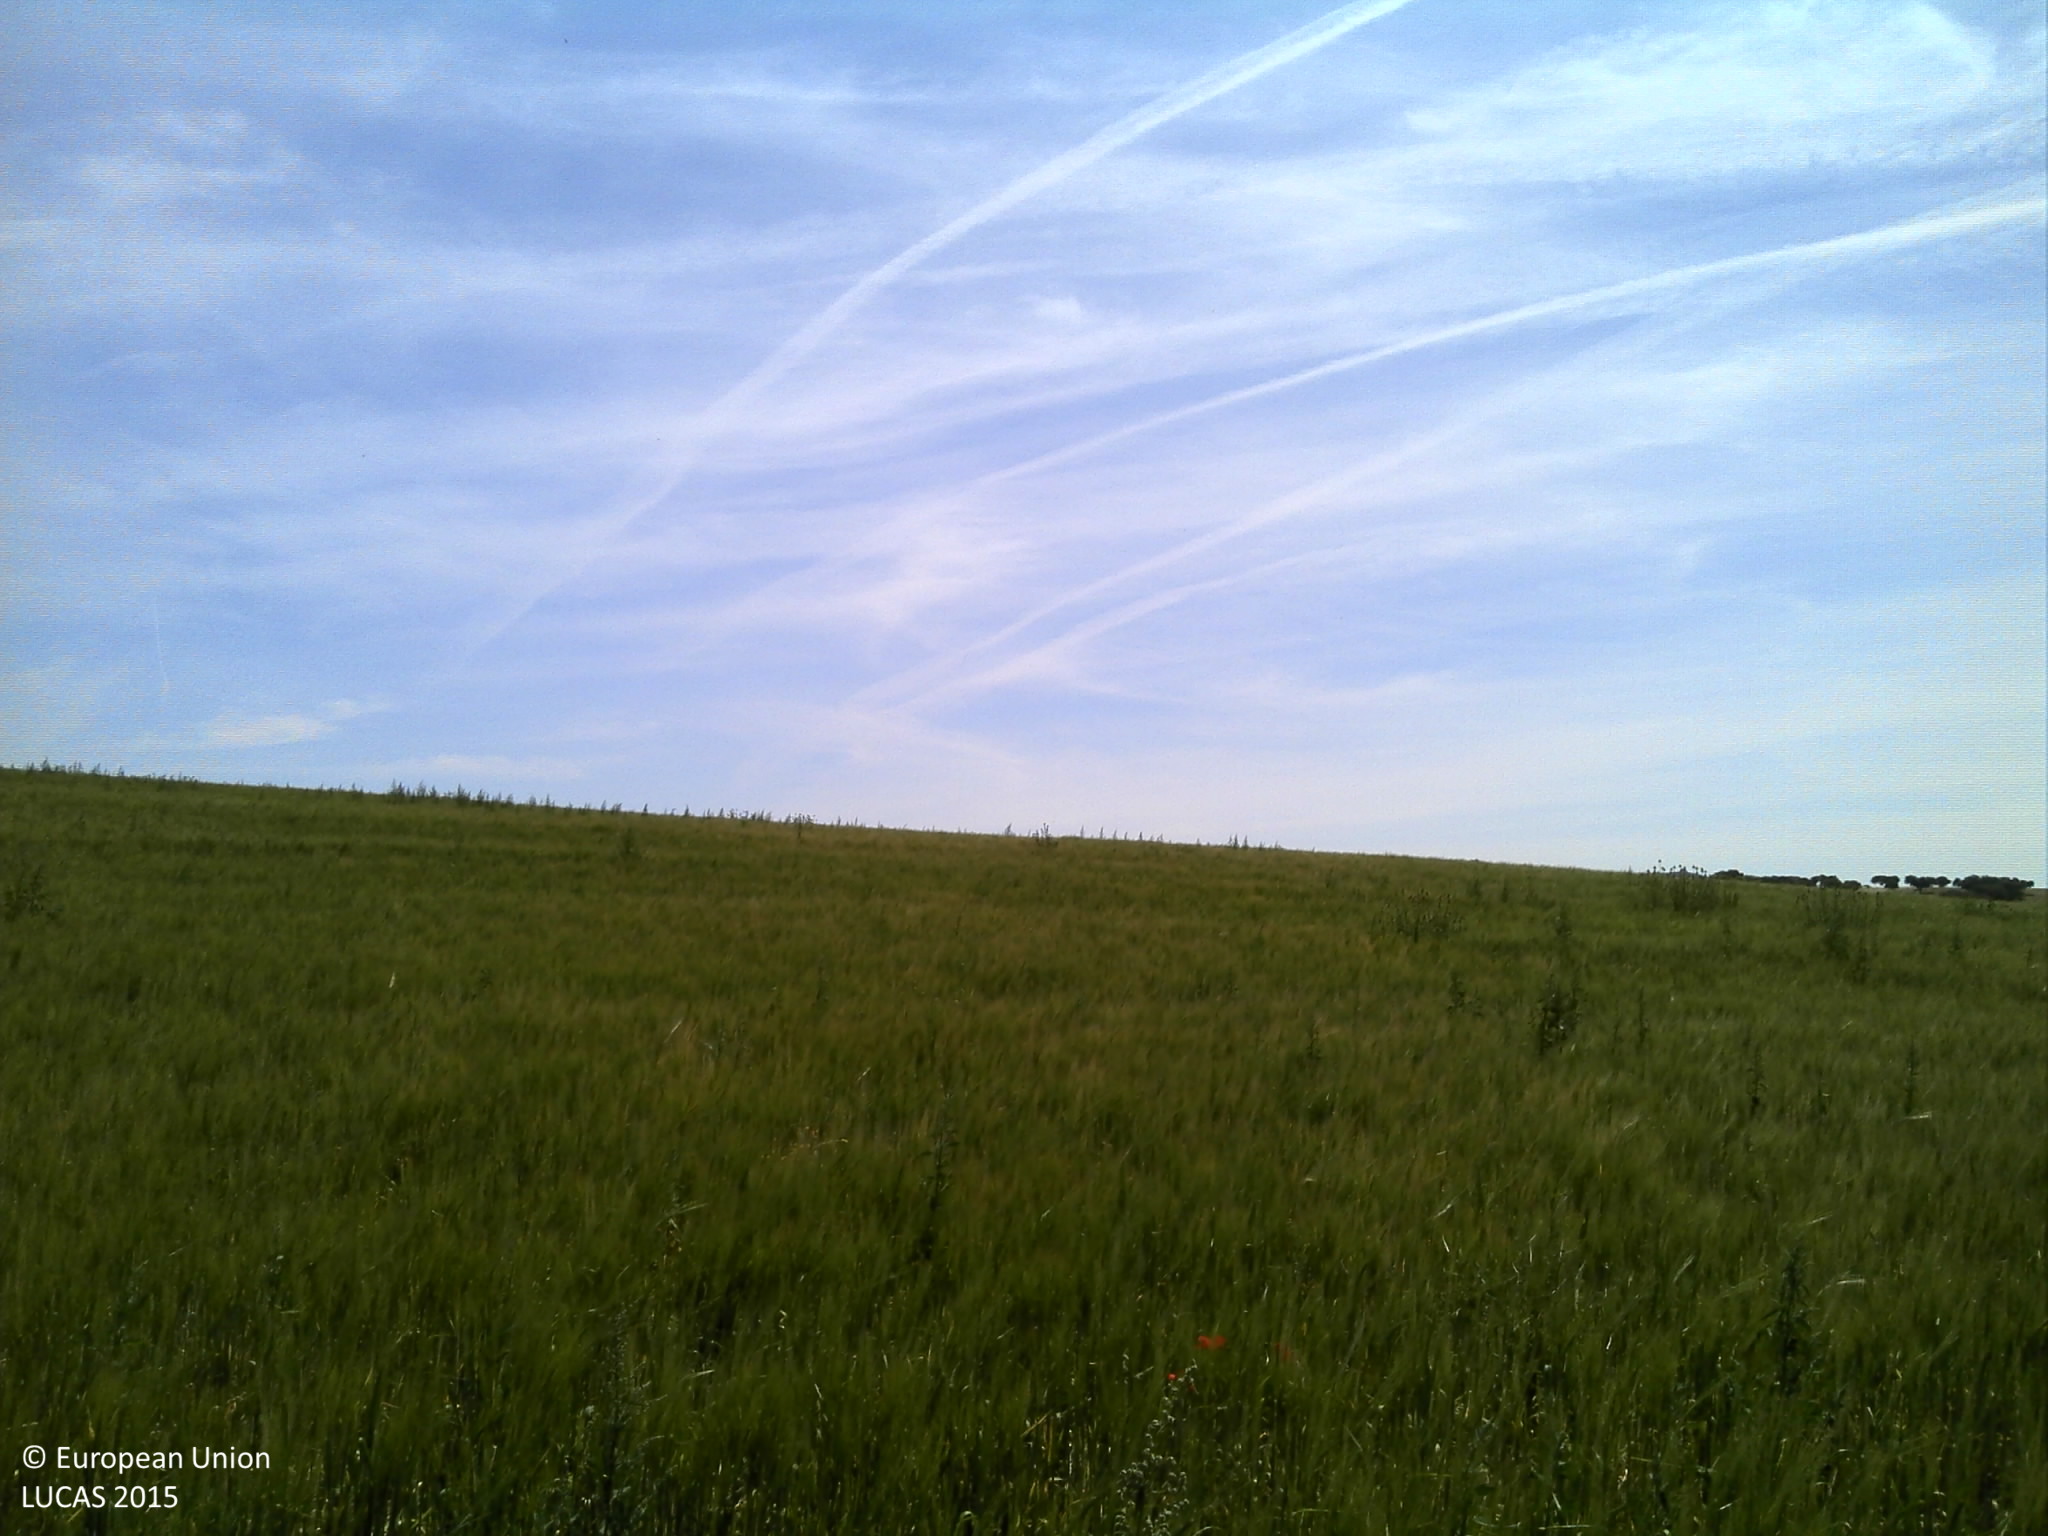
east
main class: Cropland
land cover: Barley
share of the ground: > 75 %
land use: Agriculture (excluding fallow land and kitchen gardens)
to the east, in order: Barley; Fences; Spontaneously vegetated surfaces
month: May
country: PT
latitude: 39.1081
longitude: -7.5848
